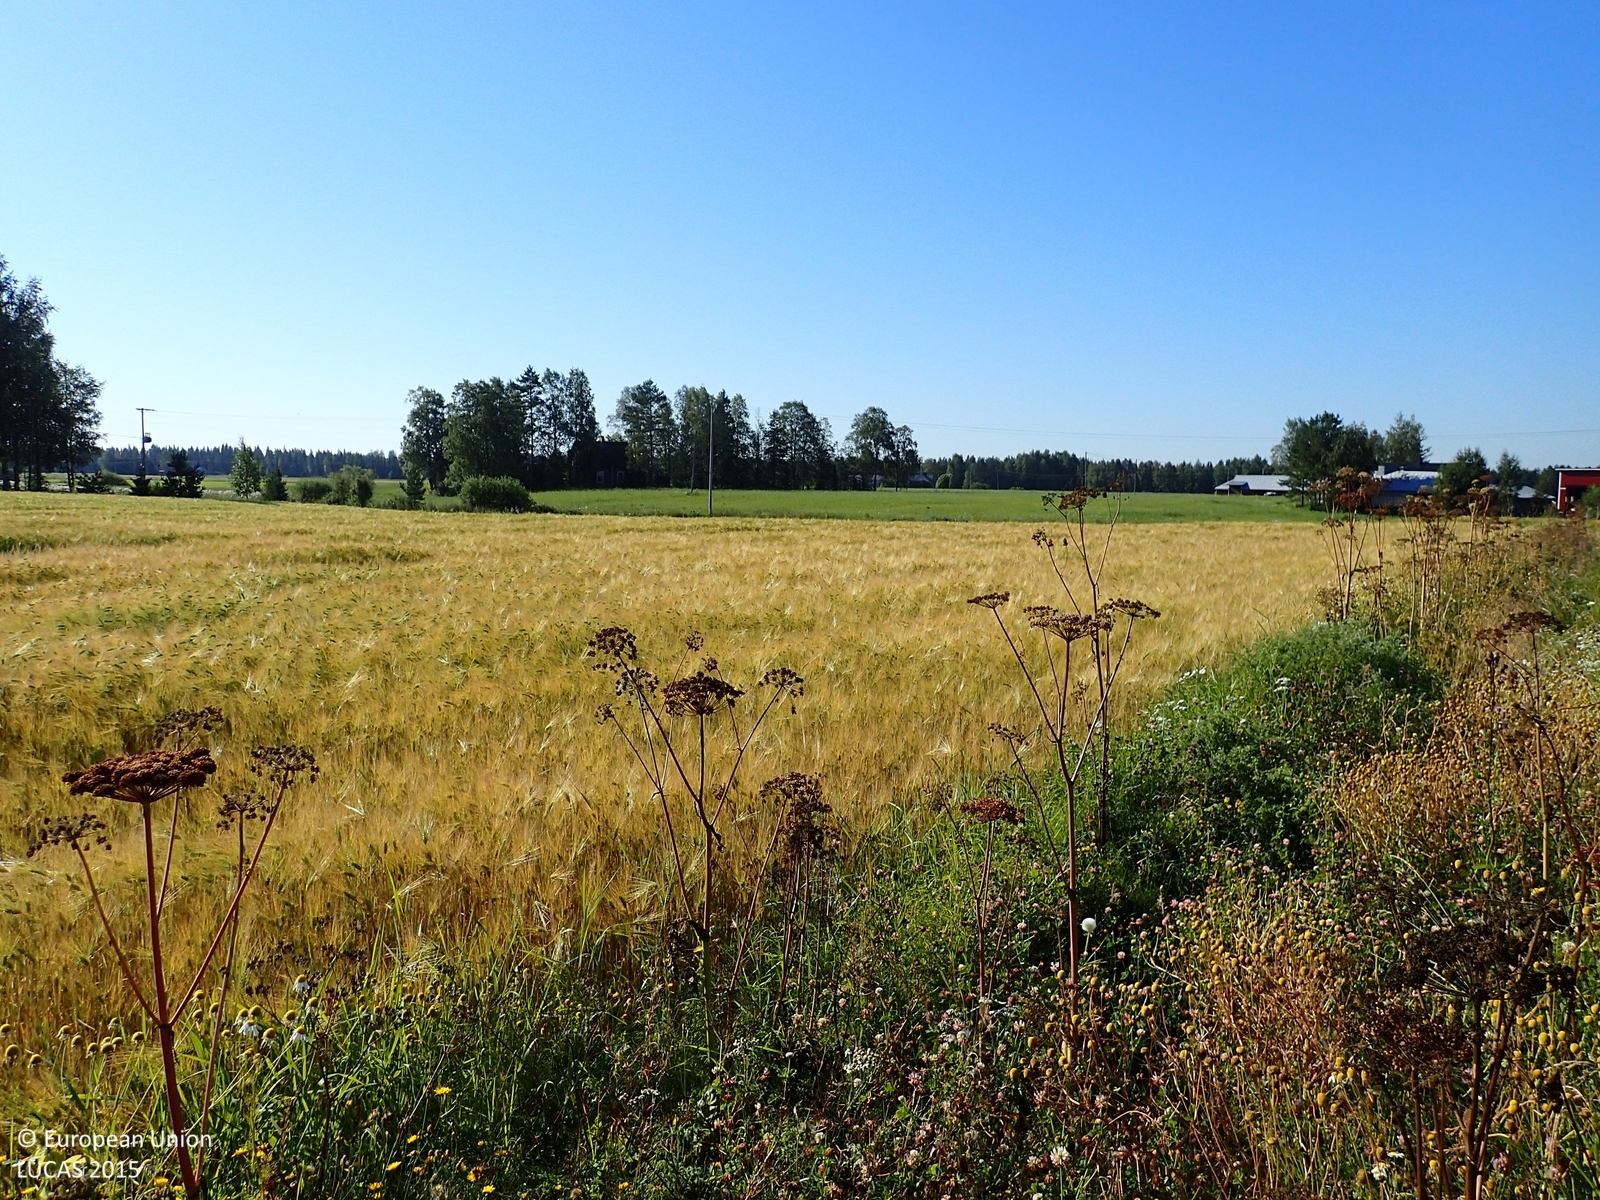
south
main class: Cropland
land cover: Barley
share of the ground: > 75 %
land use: Agriculture (excluding fallow land and kitchen gardens)
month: August
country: FI
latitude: 62.4916
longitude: 21.8273
